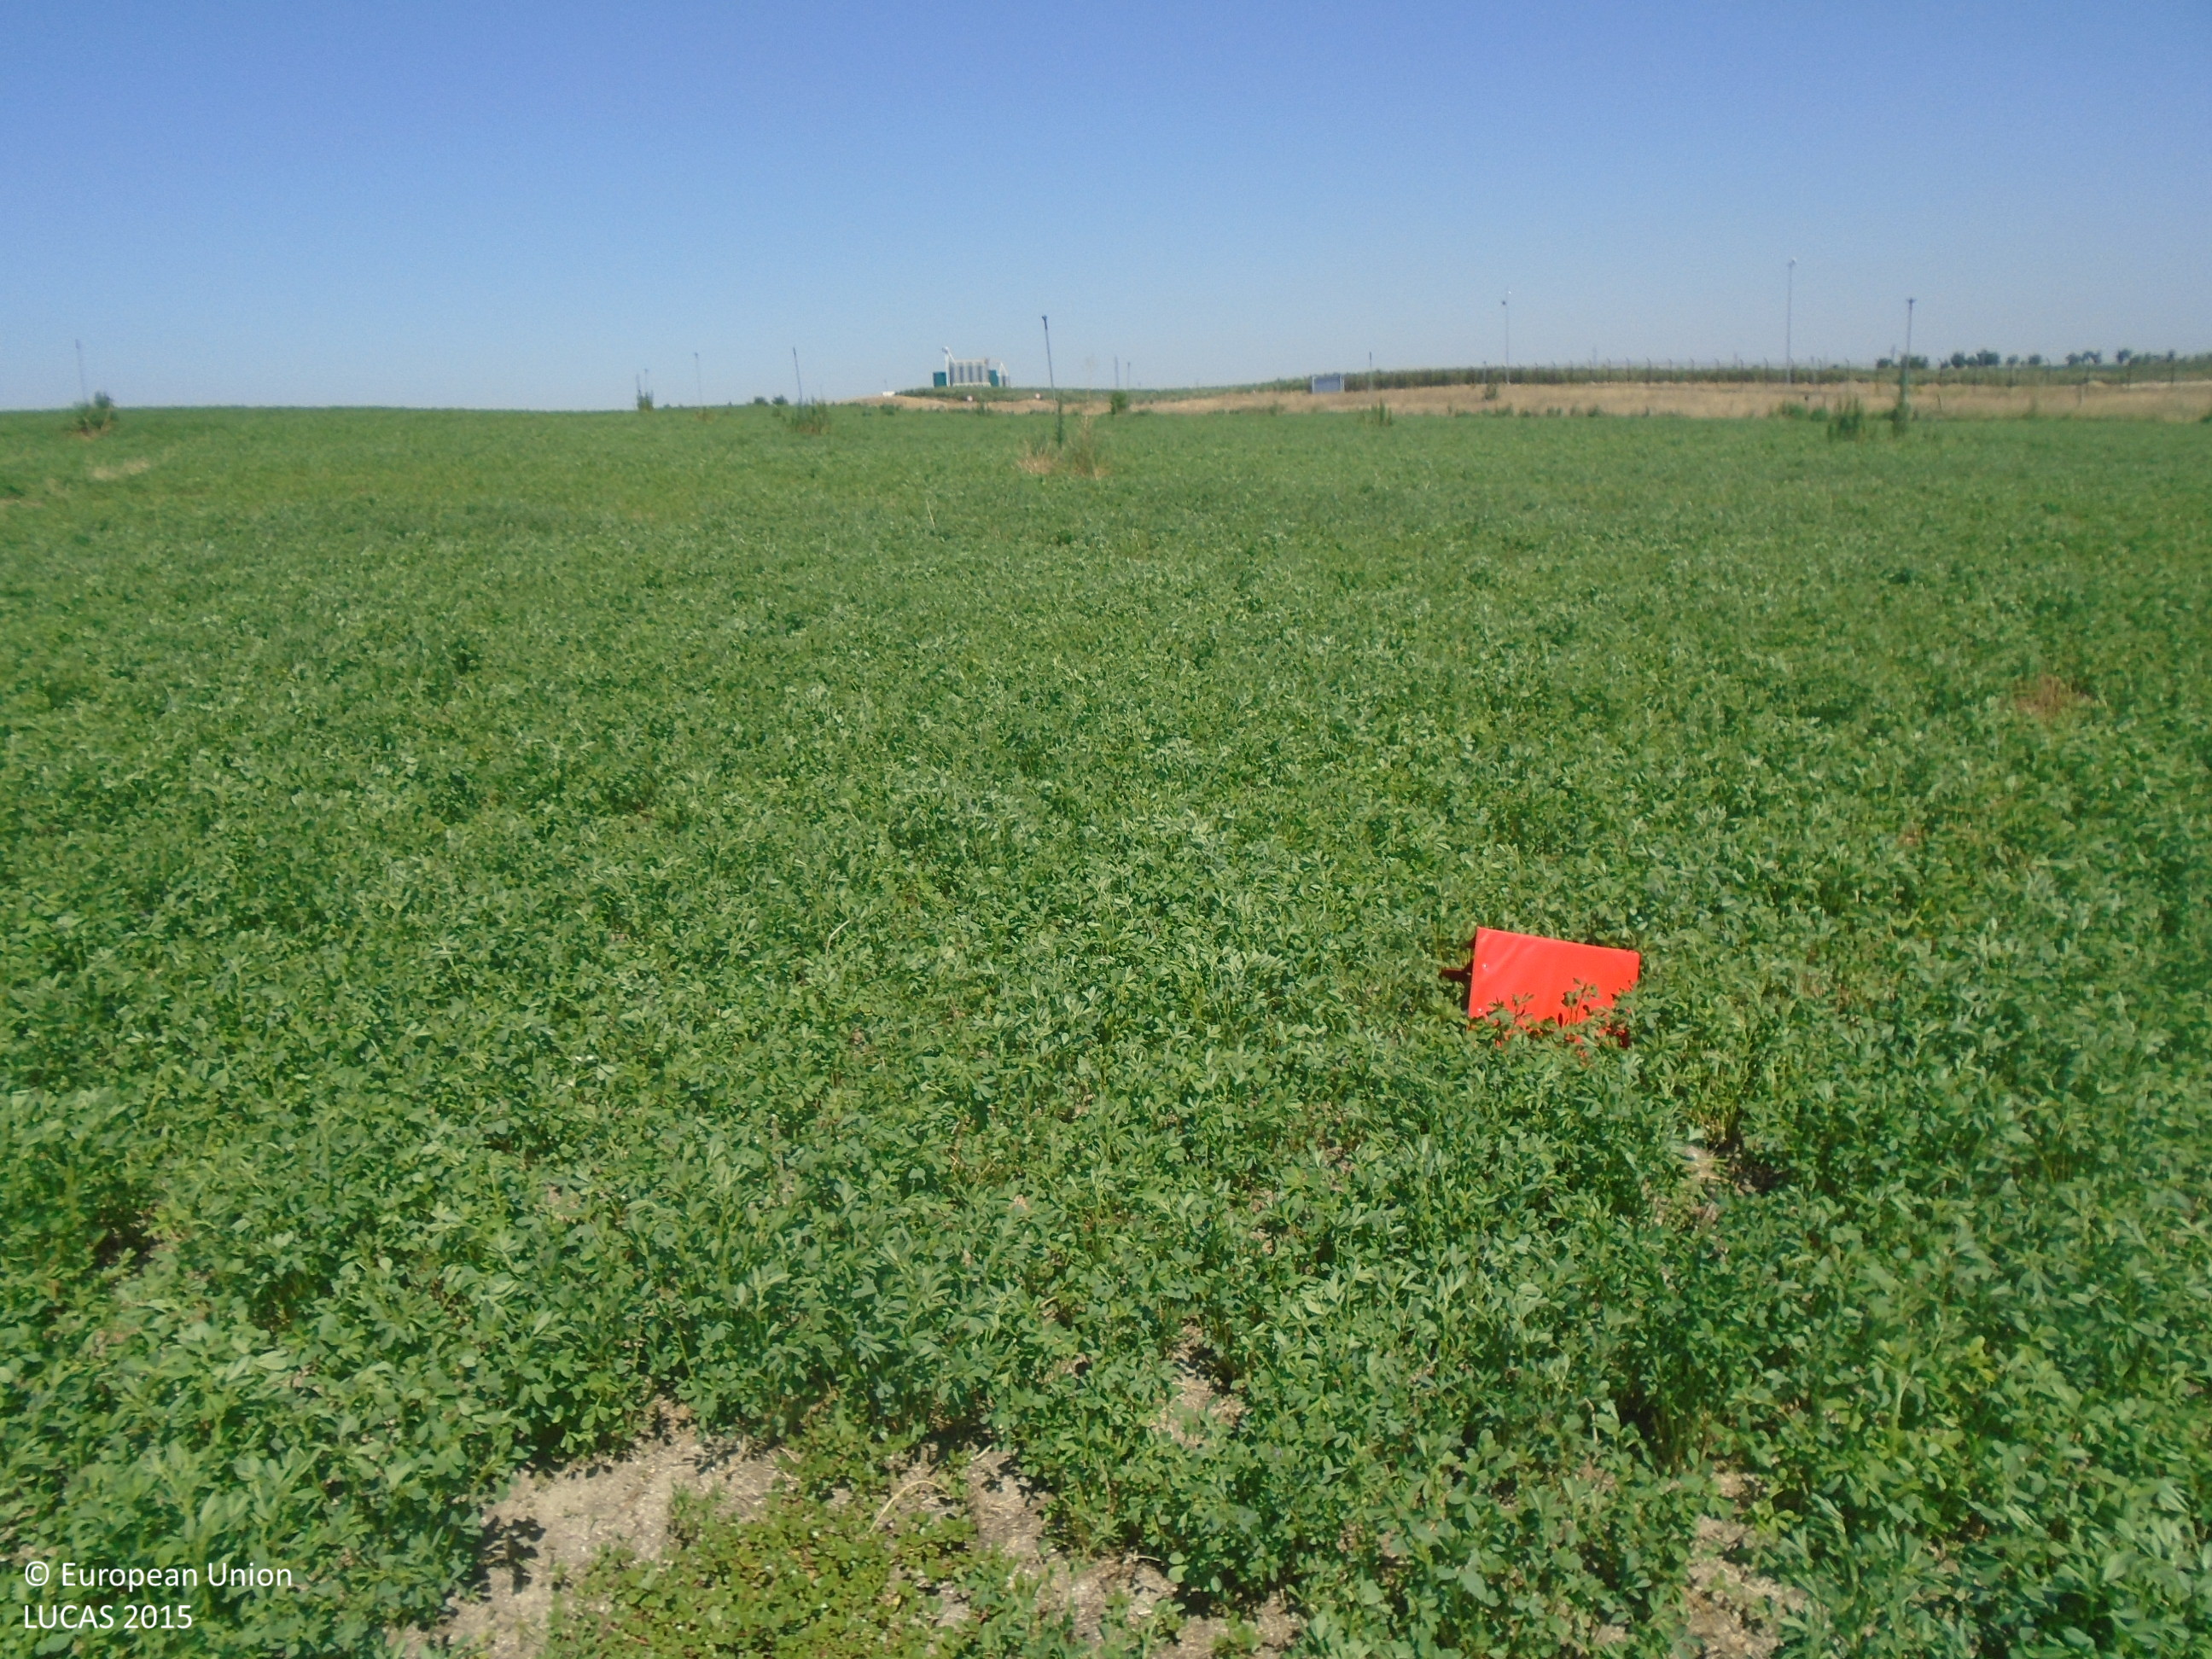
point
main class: Cropland
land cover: Lucerne
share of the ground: > 75 %
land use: Agriculture (excluding fallow land and kitchen gardens)
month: July
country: ES
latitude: 39.8243
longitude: -5.1102
